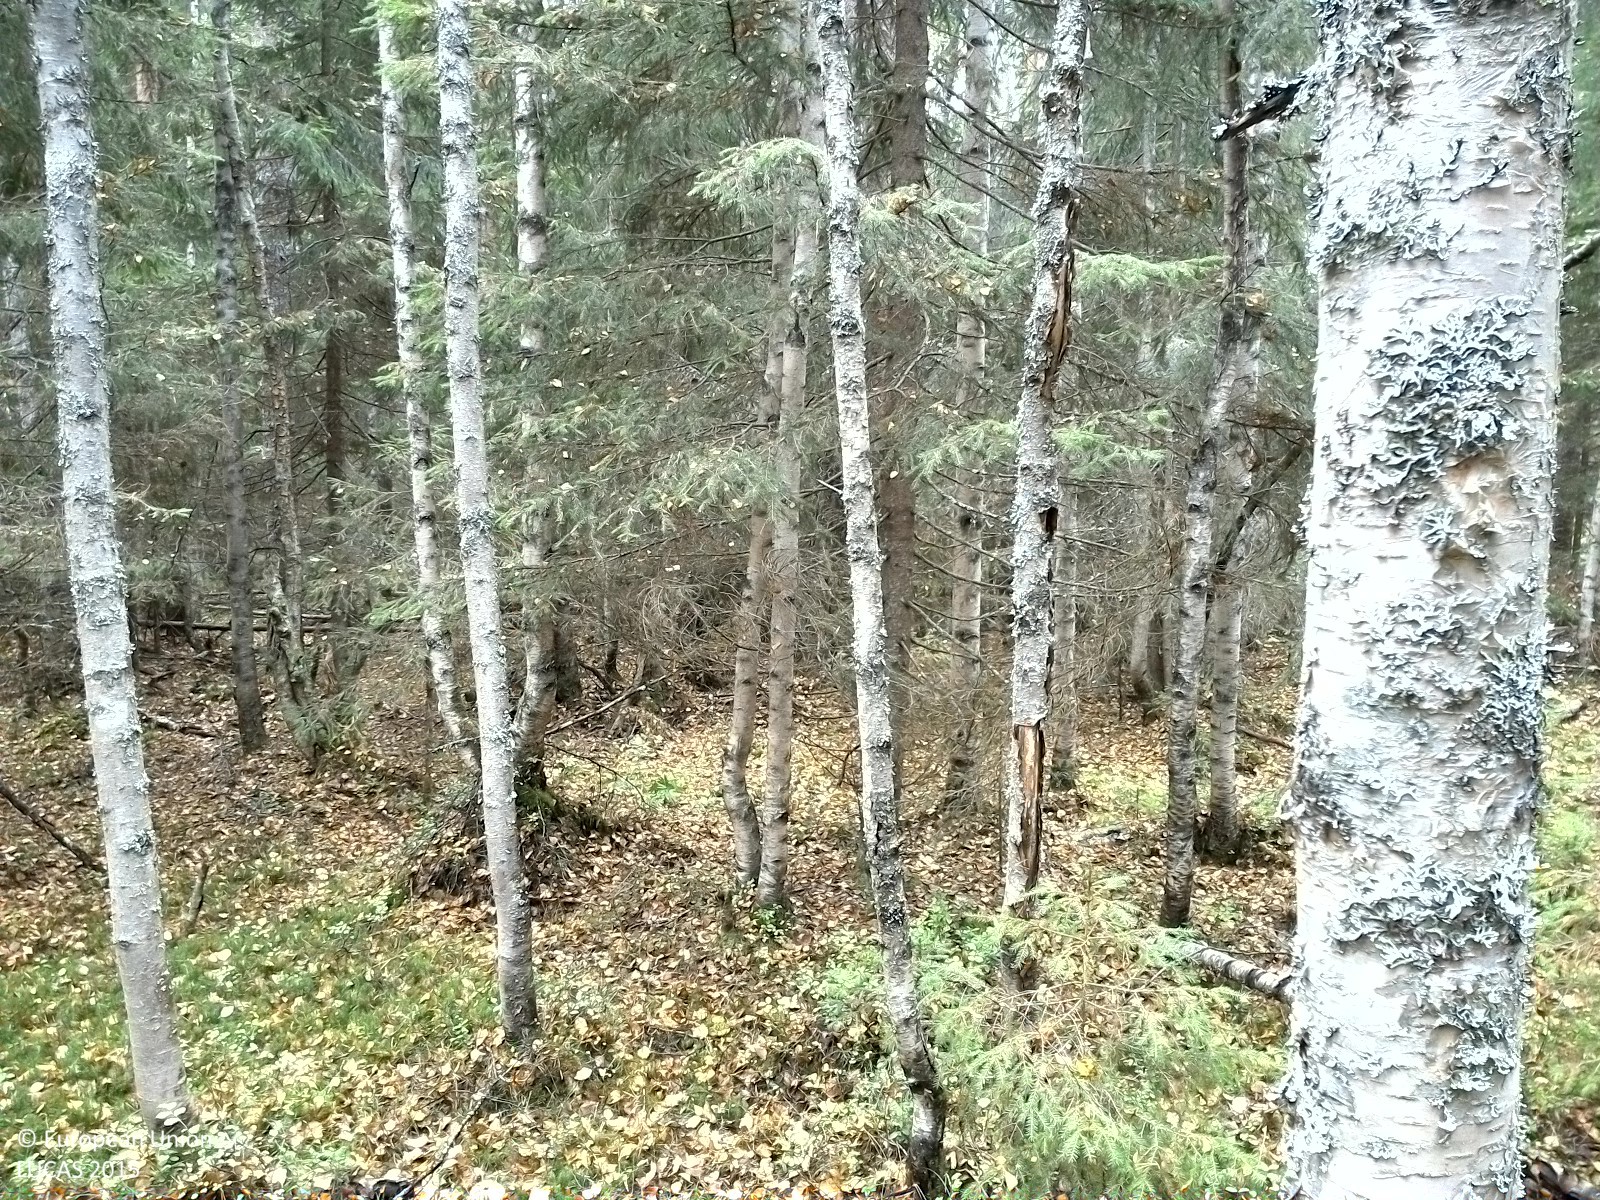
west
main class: Woodland
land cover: Other mixed woodland
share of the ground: > 75 %
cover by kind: coniferous forest trees 50 %, broadleaved forest trees 20 %, lichens and mosses 20 %, shrubs 10 %
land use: Forestry
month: October
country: SE
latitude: 62.5321
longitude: 17.5397
